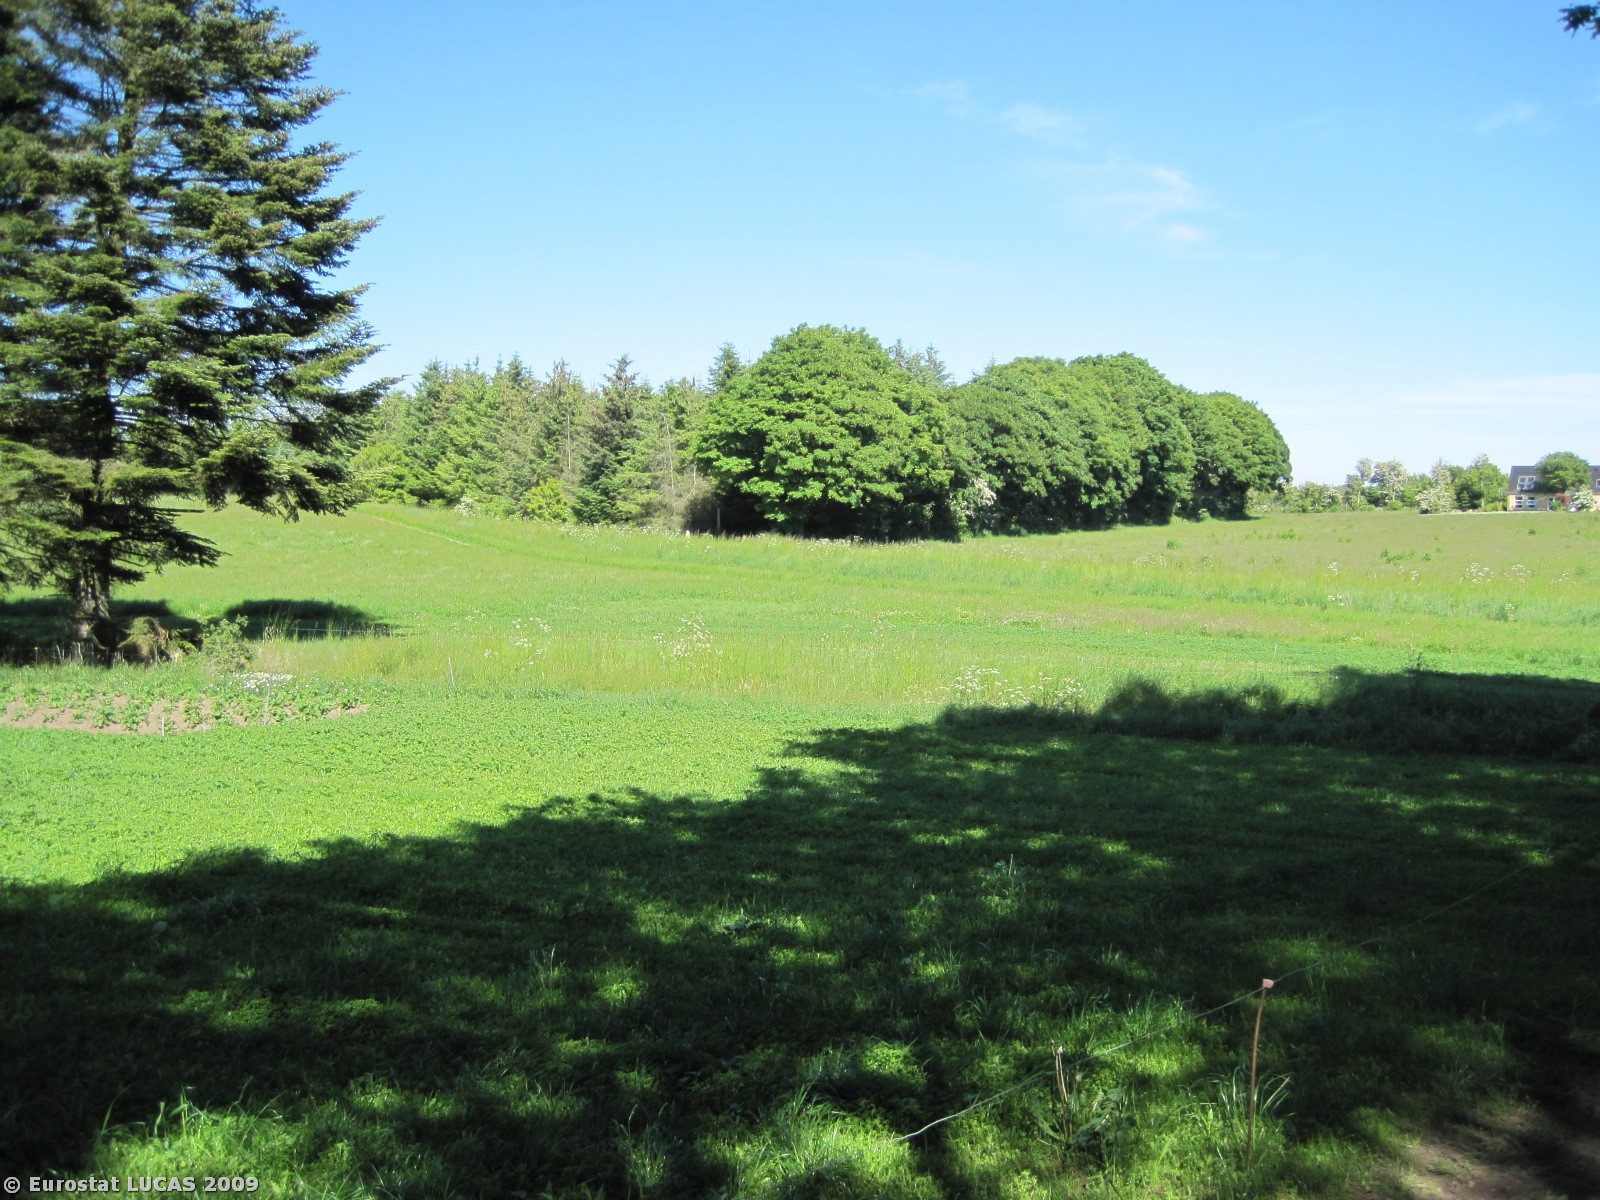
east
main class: Grassland
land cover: Grassland without tree/shrub cover
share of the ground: > 75 %
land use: Agriculture (excluding fallow land and kitchen gardens)
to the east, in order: Grassland without tree/shrub cover; Fences; Grassland without tree/shrub cover; Fences; Grass margins; Ditches and canals; Grass margins; Abandoned hedges; Grass margins; Fences; Grassland without tree/shrub cover; Fences; Grassland without tree/shrub cover; Paved roads, cycling and walking lanes; Grass margins; Fences; Coniferous woodland; Grassland without tree/shrub cover; Fences; Grass margins; Tracks
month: June
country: DK
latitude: 57.5181
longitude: 10.0833
